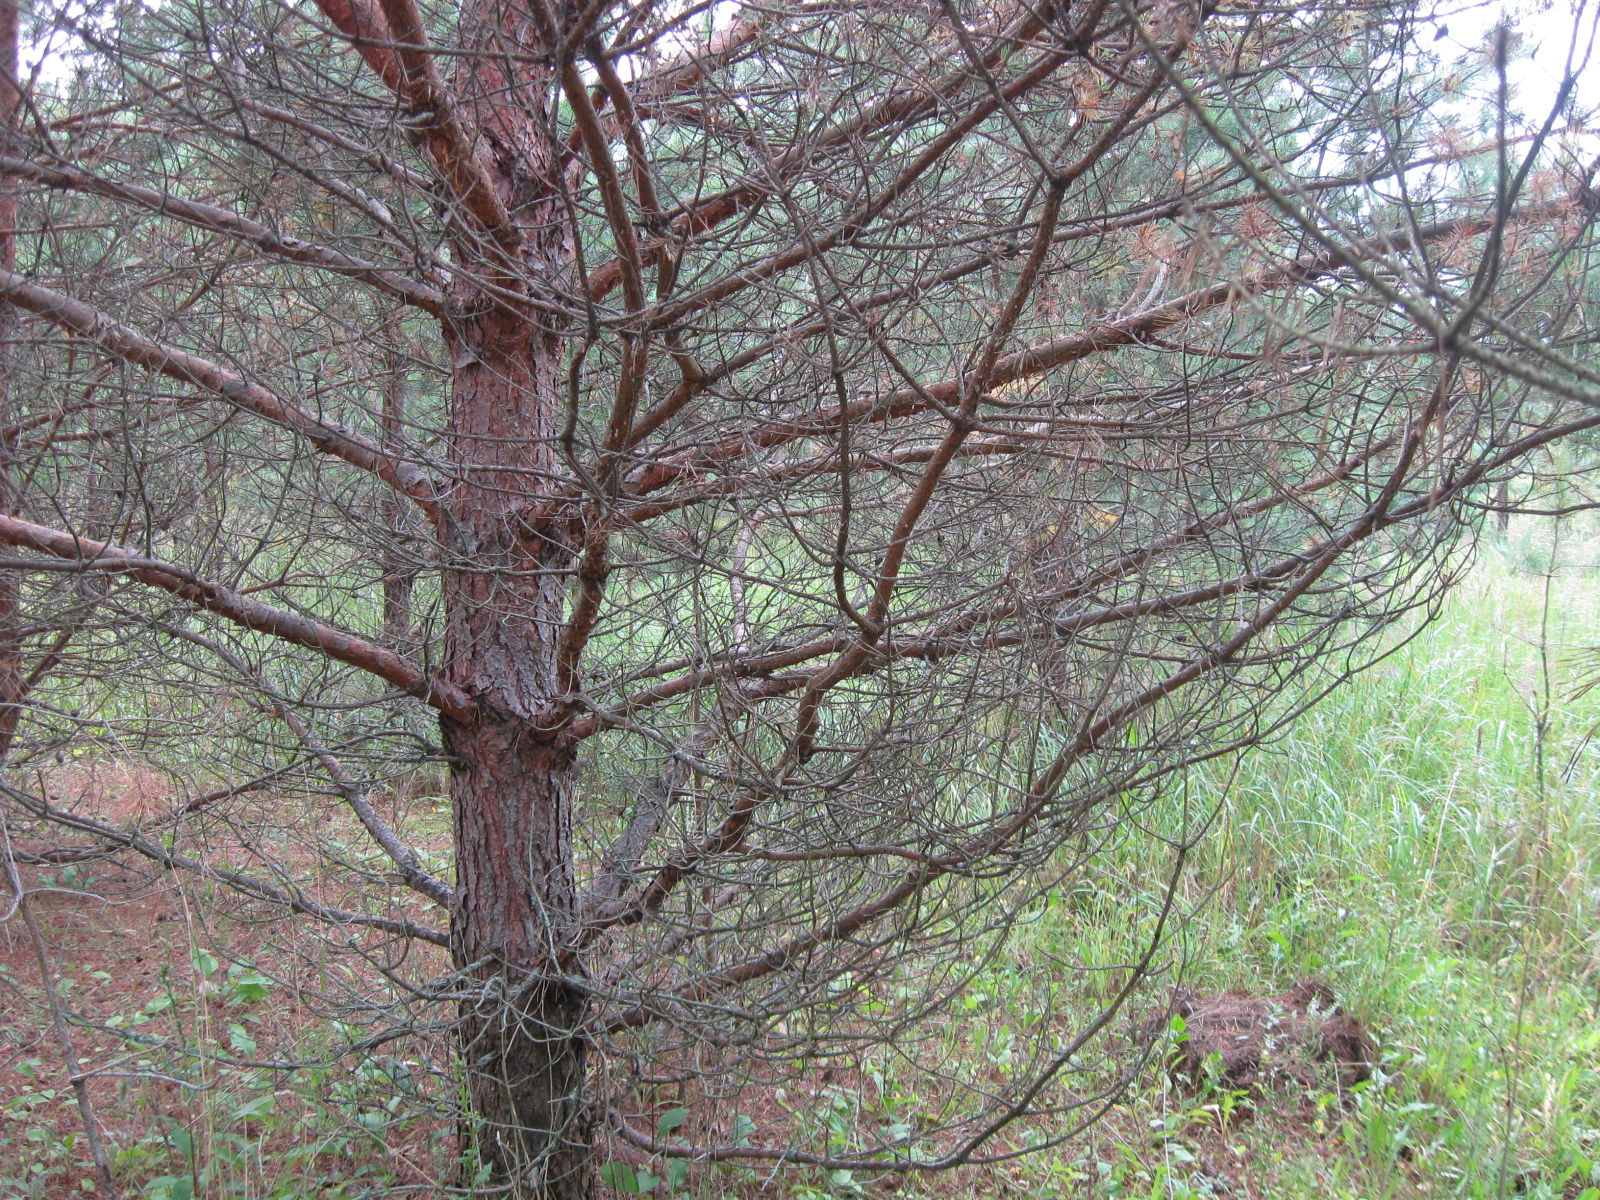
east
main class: Woodland
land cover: Pine dominated coniferous woodland
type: hemiboreal forest and nemoral coniferous forest and mixed broadleaved-coniferous forest
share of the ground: 50 - 75 %
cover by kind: coniferous forest trees 70 %, herbaceous plants 25 %, unconsolidated bare surface 5 %
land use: Forestry
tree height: < 5 m
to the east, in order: Pine dominated coniferous woodland; Tracks; Pine dominated coniferous woodland; Pine dominated mixed woodland; Pine dominated coniferous woodland
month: July
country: LT
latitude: 54.4058
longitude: 24.3504
